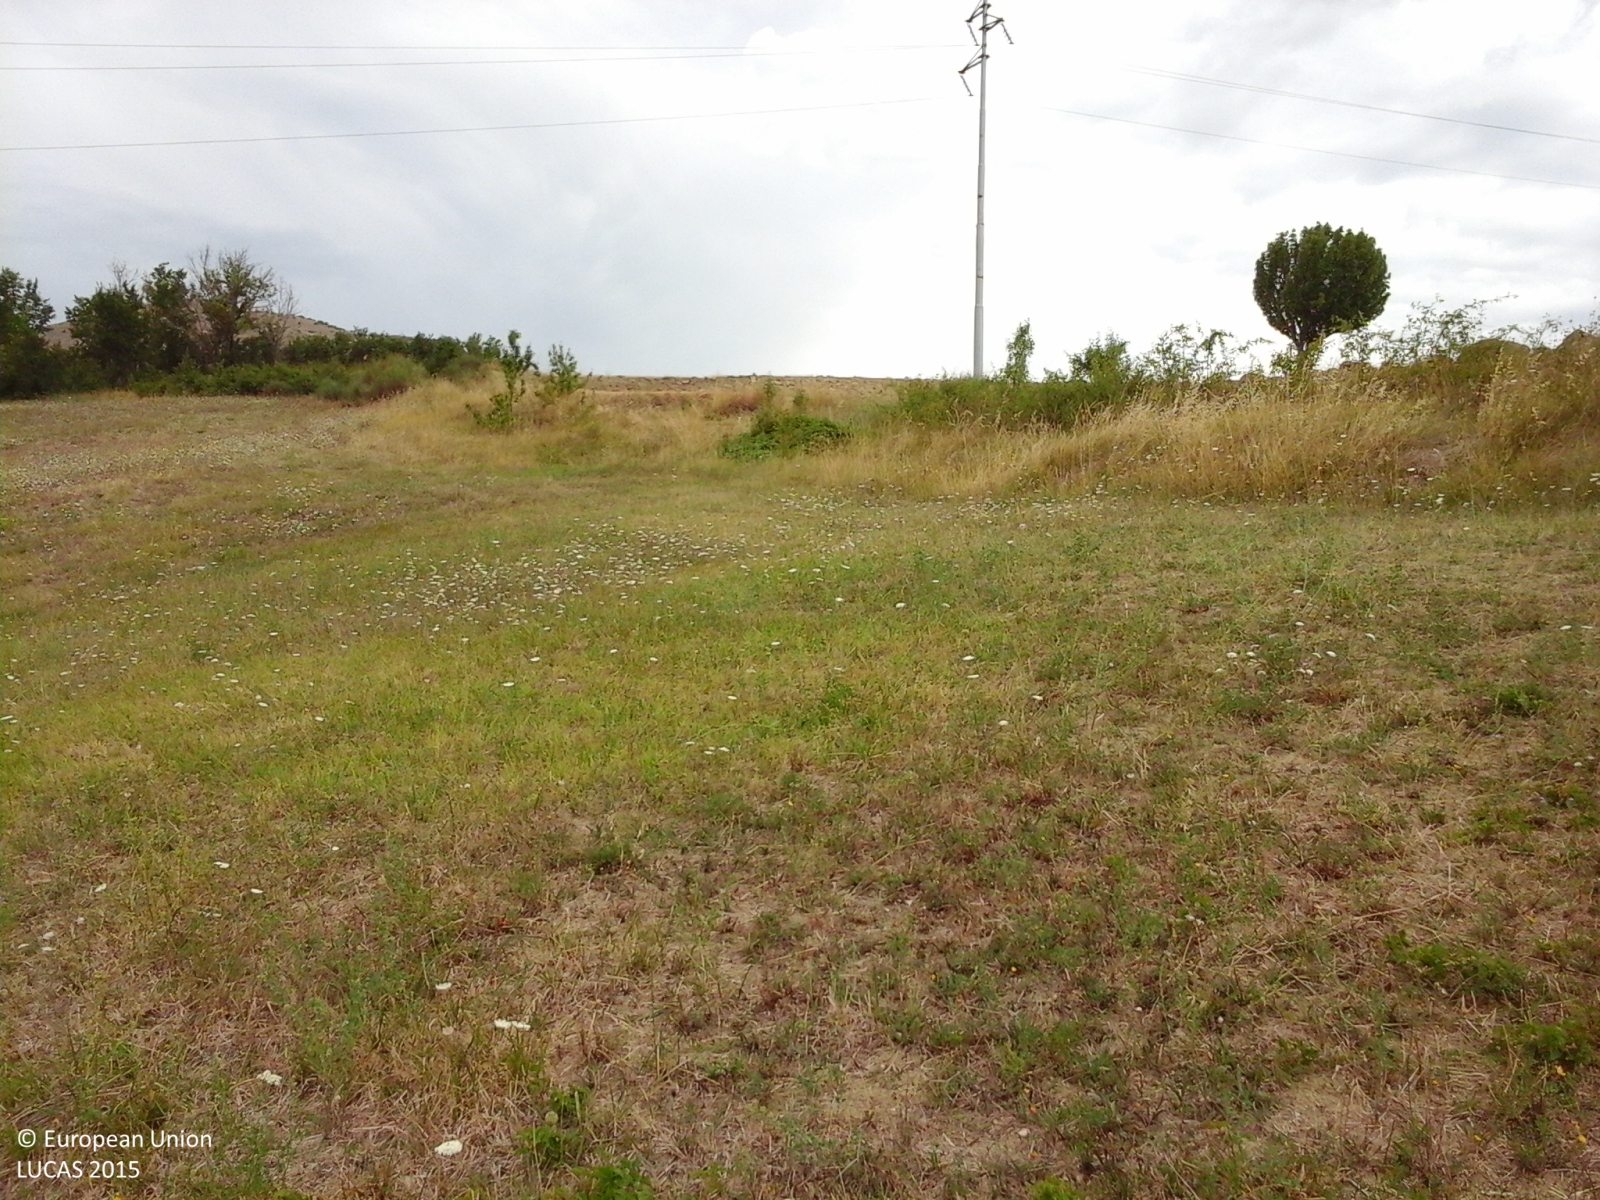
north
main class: Cropland
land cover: Temporary grasslands
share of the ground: > 75 %
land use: Agriculture (excluding fallow land and kitchen gardens)
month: August
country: IT
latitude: 41.8346
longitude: 14.4045
